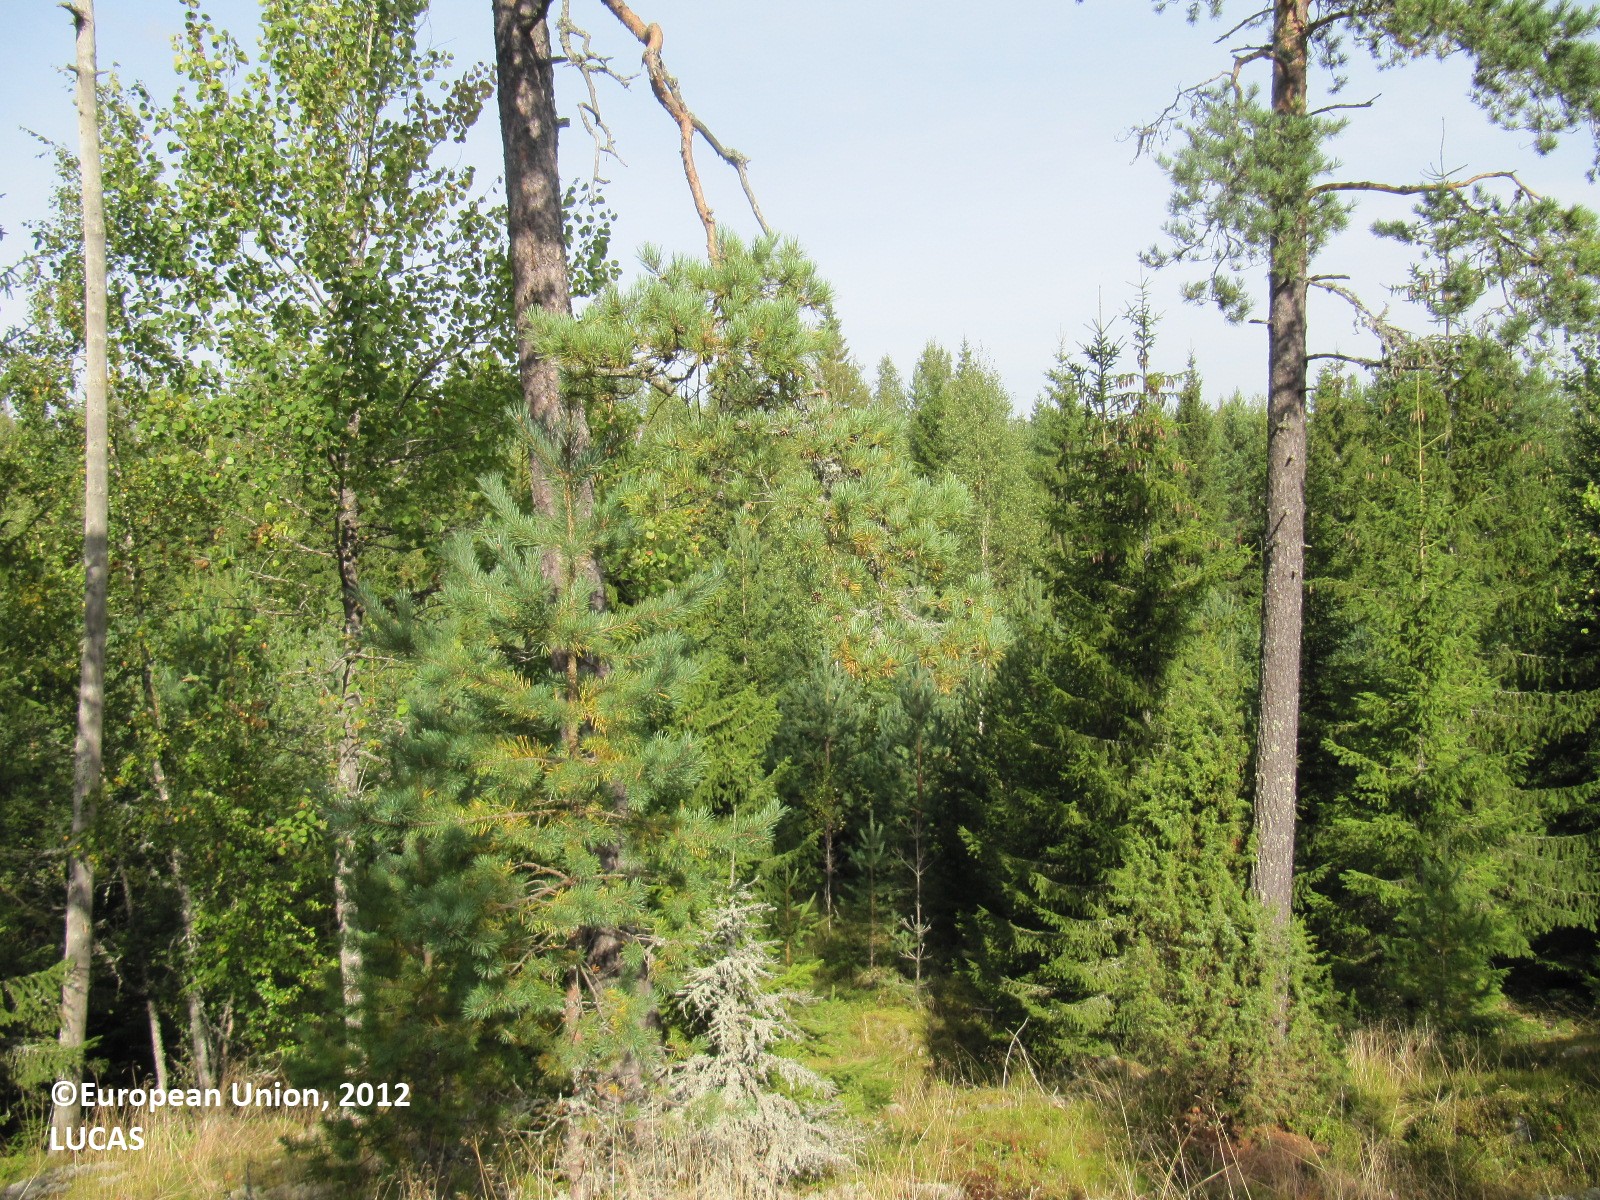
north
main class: Woodland
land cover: Pine dominated mixed woodland
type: boreal forest
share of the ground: 25 - 50 %
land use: Forestry
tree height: > 5 m
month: August
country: FI
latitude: 61.0120
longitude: 22.8918
